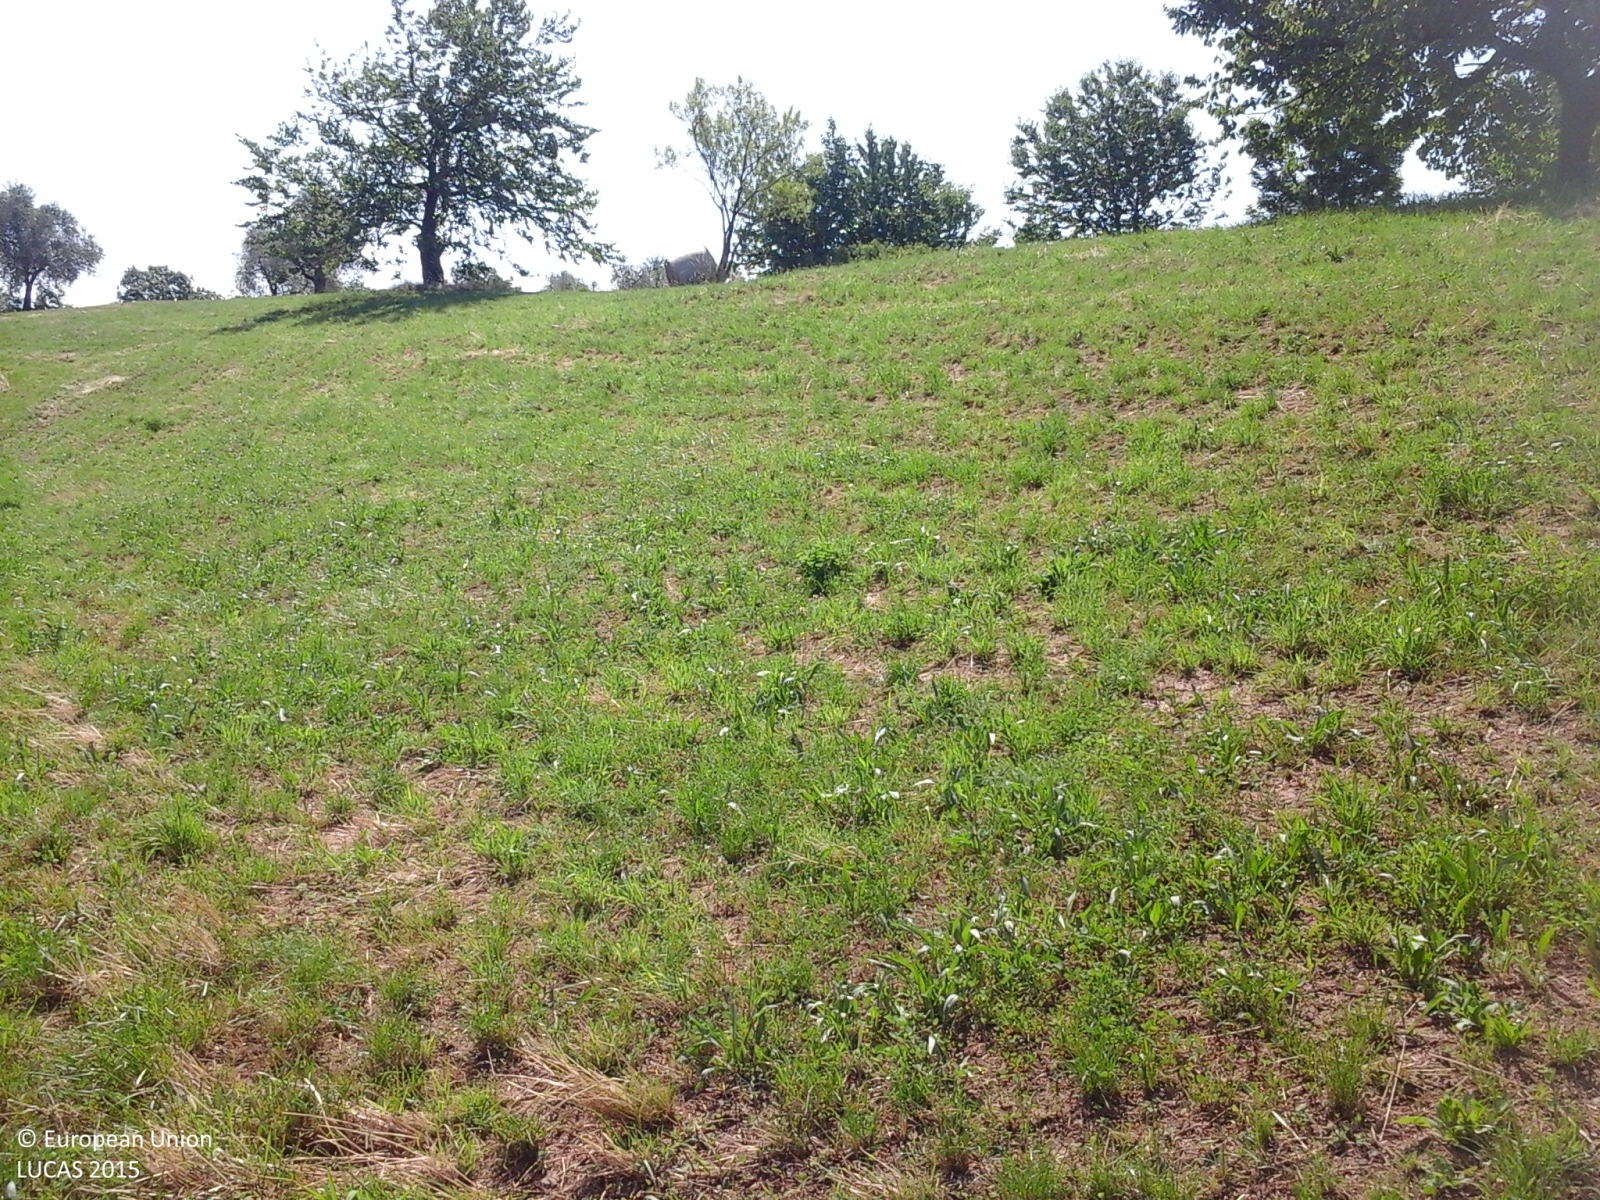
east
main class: Grassland
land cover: Grassland without tree/shrub cover
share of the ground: > 75 %
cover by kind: herbaceous plants 100 %
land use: Agriculture (excluding fallow land and kitchen gardens)
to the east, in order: Grassland without tree/shrub cover; Shrubland without tree cover; Broadleaved woodland; Artificial constructions in urban areas
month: June
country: IT
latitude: 45.5920
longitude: 10.7294
